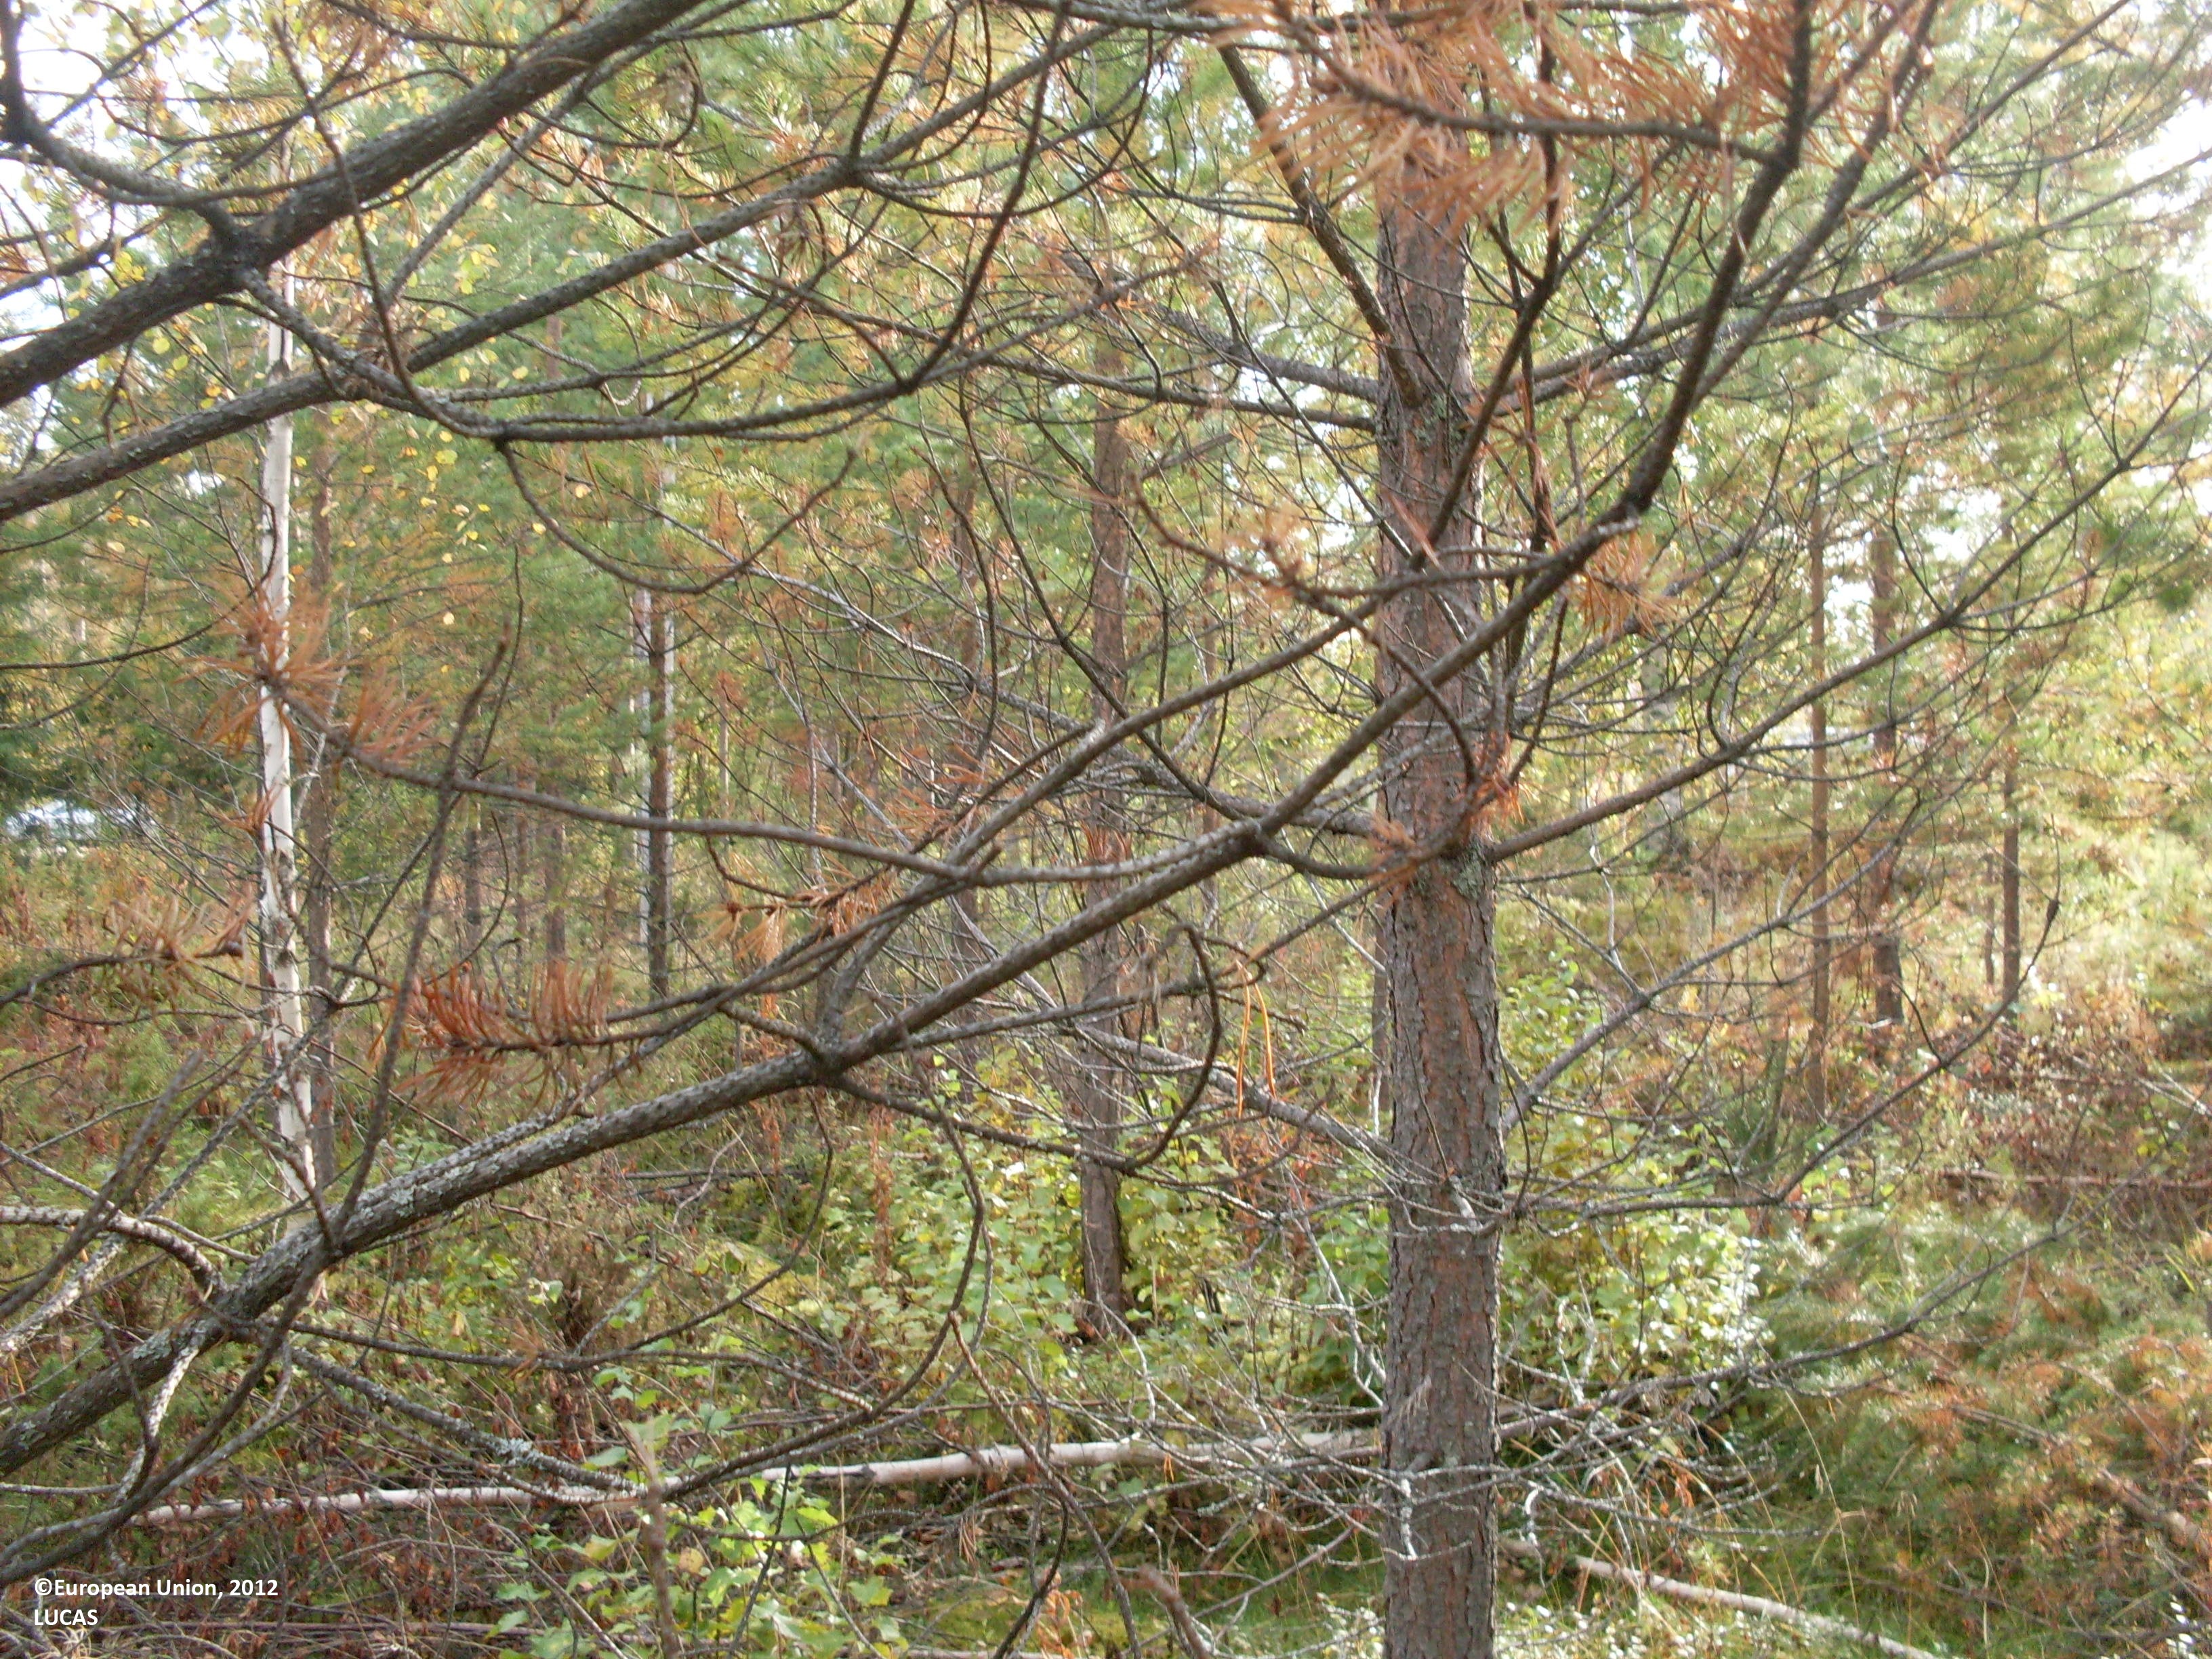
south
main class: Woodland
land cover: Pine dominated coniferous woodland
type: boreal forest
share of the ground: > 75 %
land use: Forestry
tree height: > 5 m
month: September
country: FI
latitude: 64.1234
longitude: 28.4358
